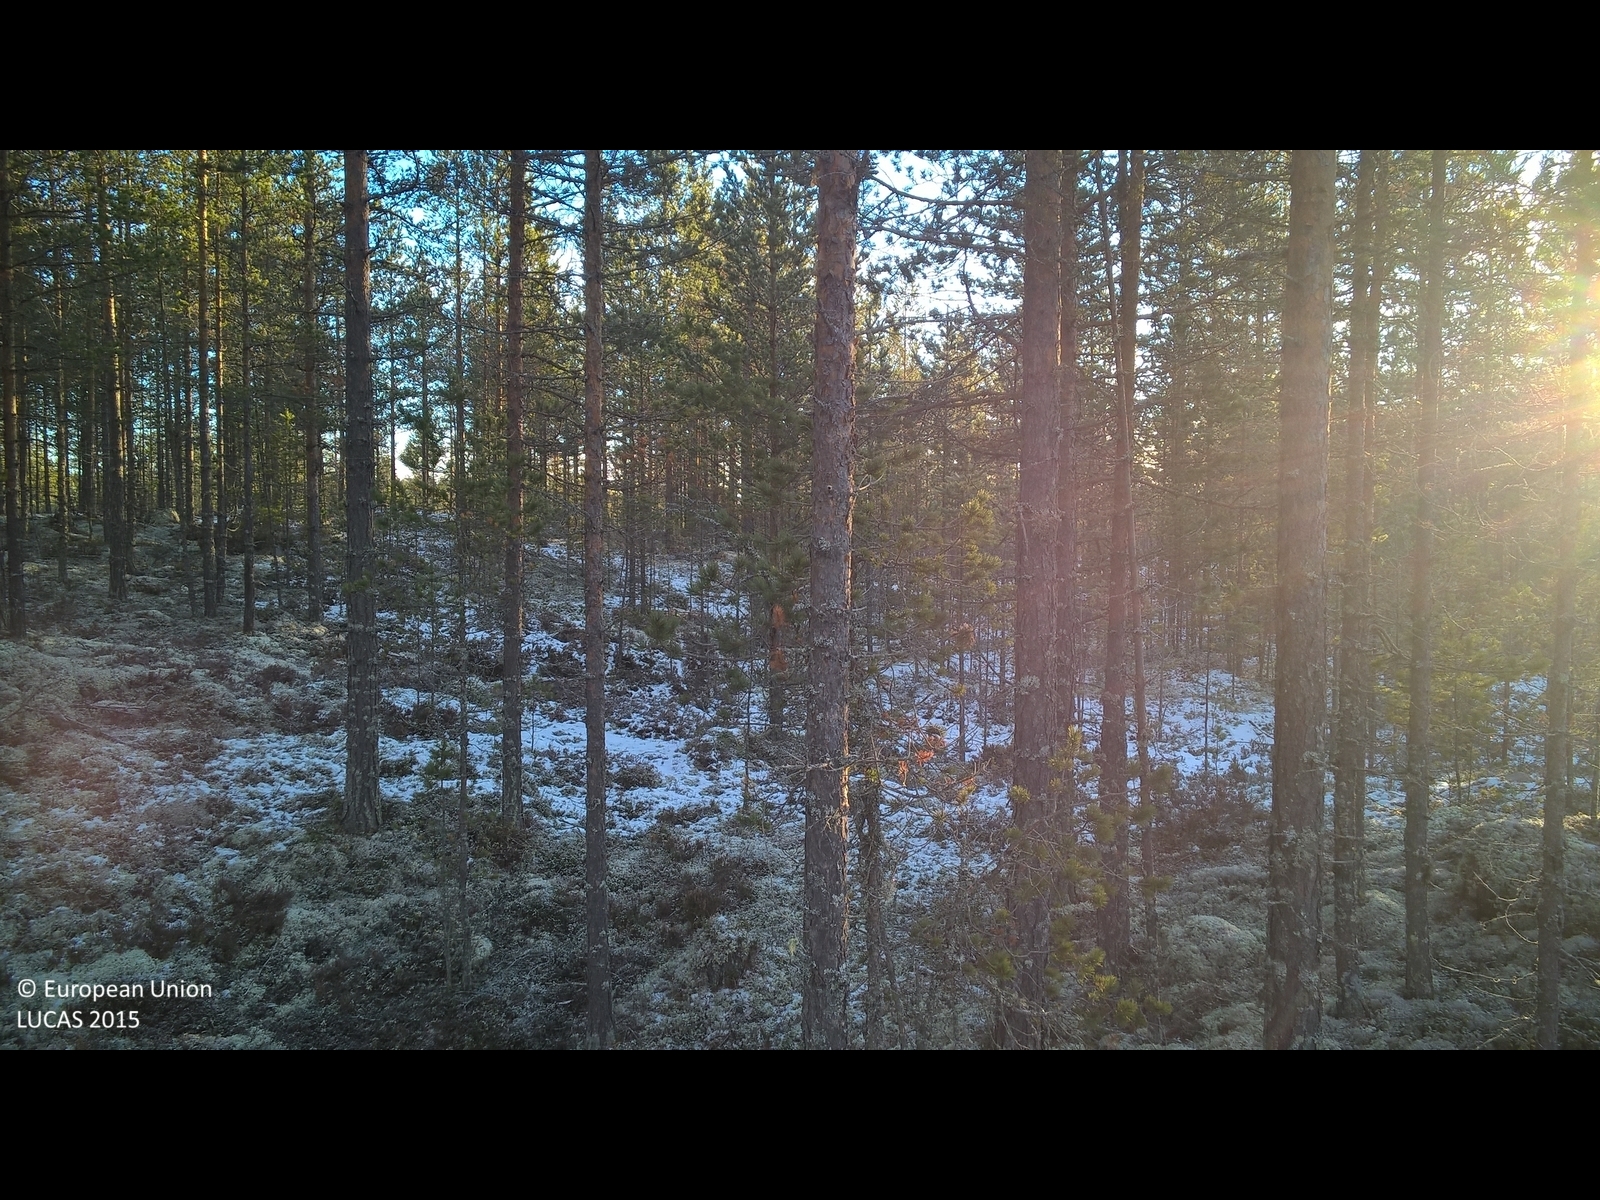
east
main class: Woodland
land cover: Pine dominated coniferous woodland
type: boreal forest
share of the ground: > 75 %
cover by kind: coniferous forest trees 75 %, lichens and mosses 25 %
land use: Forestry
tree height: > 5 m
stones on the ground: < 10 %
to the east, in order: Pine dominated coniferous woodland; Peatbogs; Pine dominated coniferous woodland
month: November
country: SE
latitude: 60.7295
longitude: 13.6010
